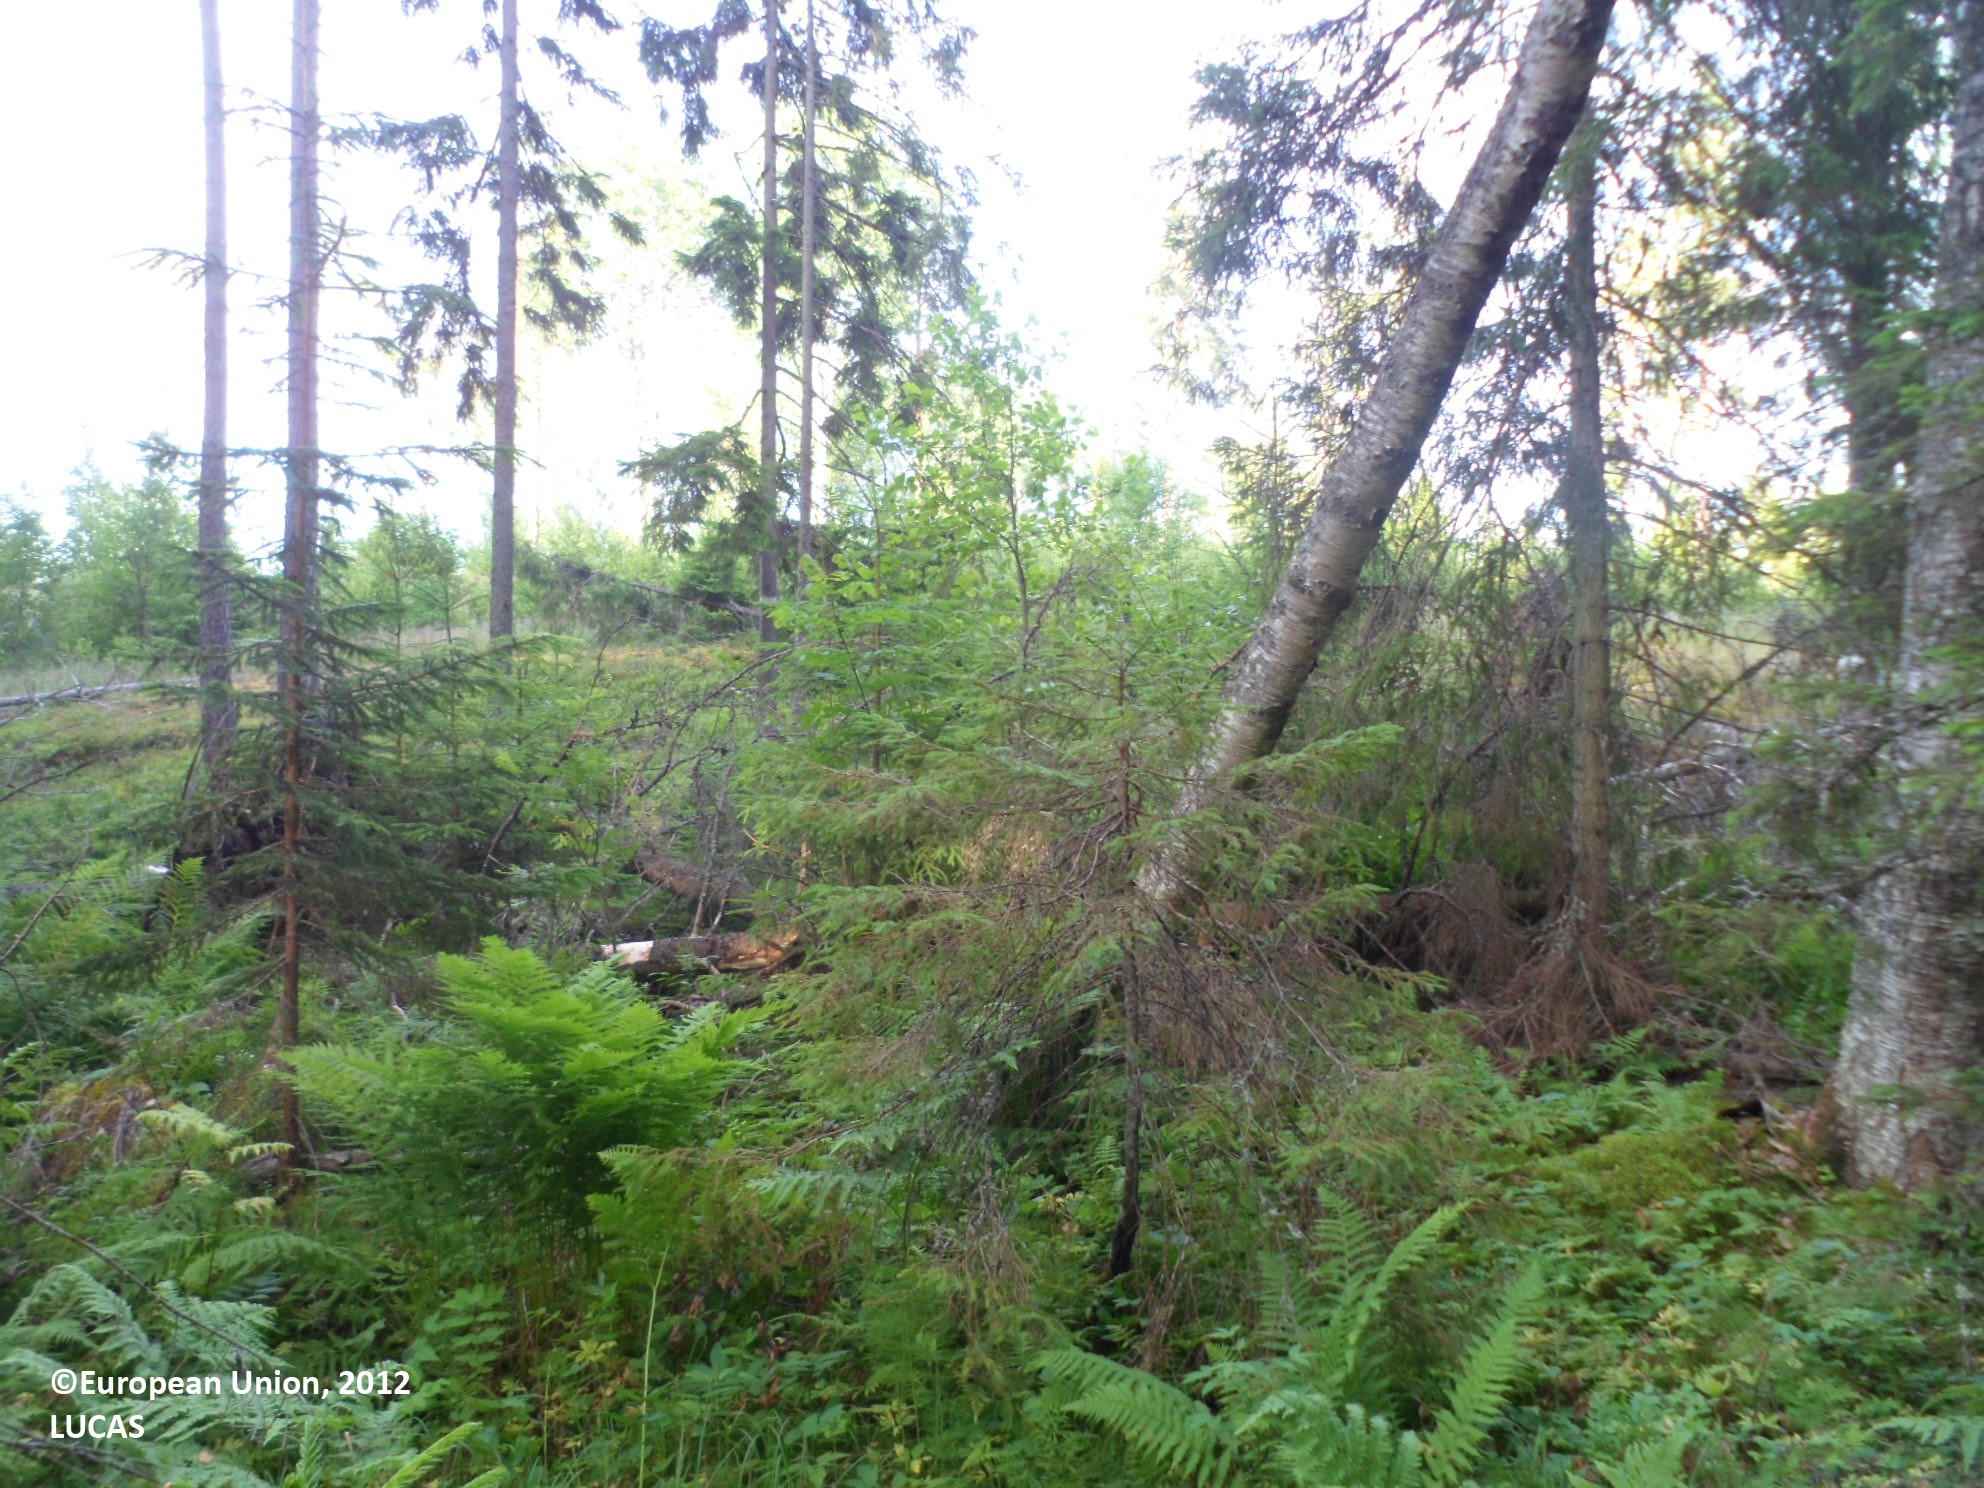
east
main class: Woodland
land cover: Spruce dominated coniferous woodland
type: boreal forest
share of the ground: > 75 %
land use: Forestry
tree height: > 5 m
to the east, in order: Spruce dominated coniferous woodland; Single bushes/trees; Spruce dominated mixed woodland; Pine dominated coniferous woodland; Pine dominated mixed woodland; Broadleaved woodland; Electric lines; Broadleaved woodland; Spruce dominated mixed woodland; Broadleaved woodland
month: July
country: SE
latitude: 59.6457
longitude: 18.6043
